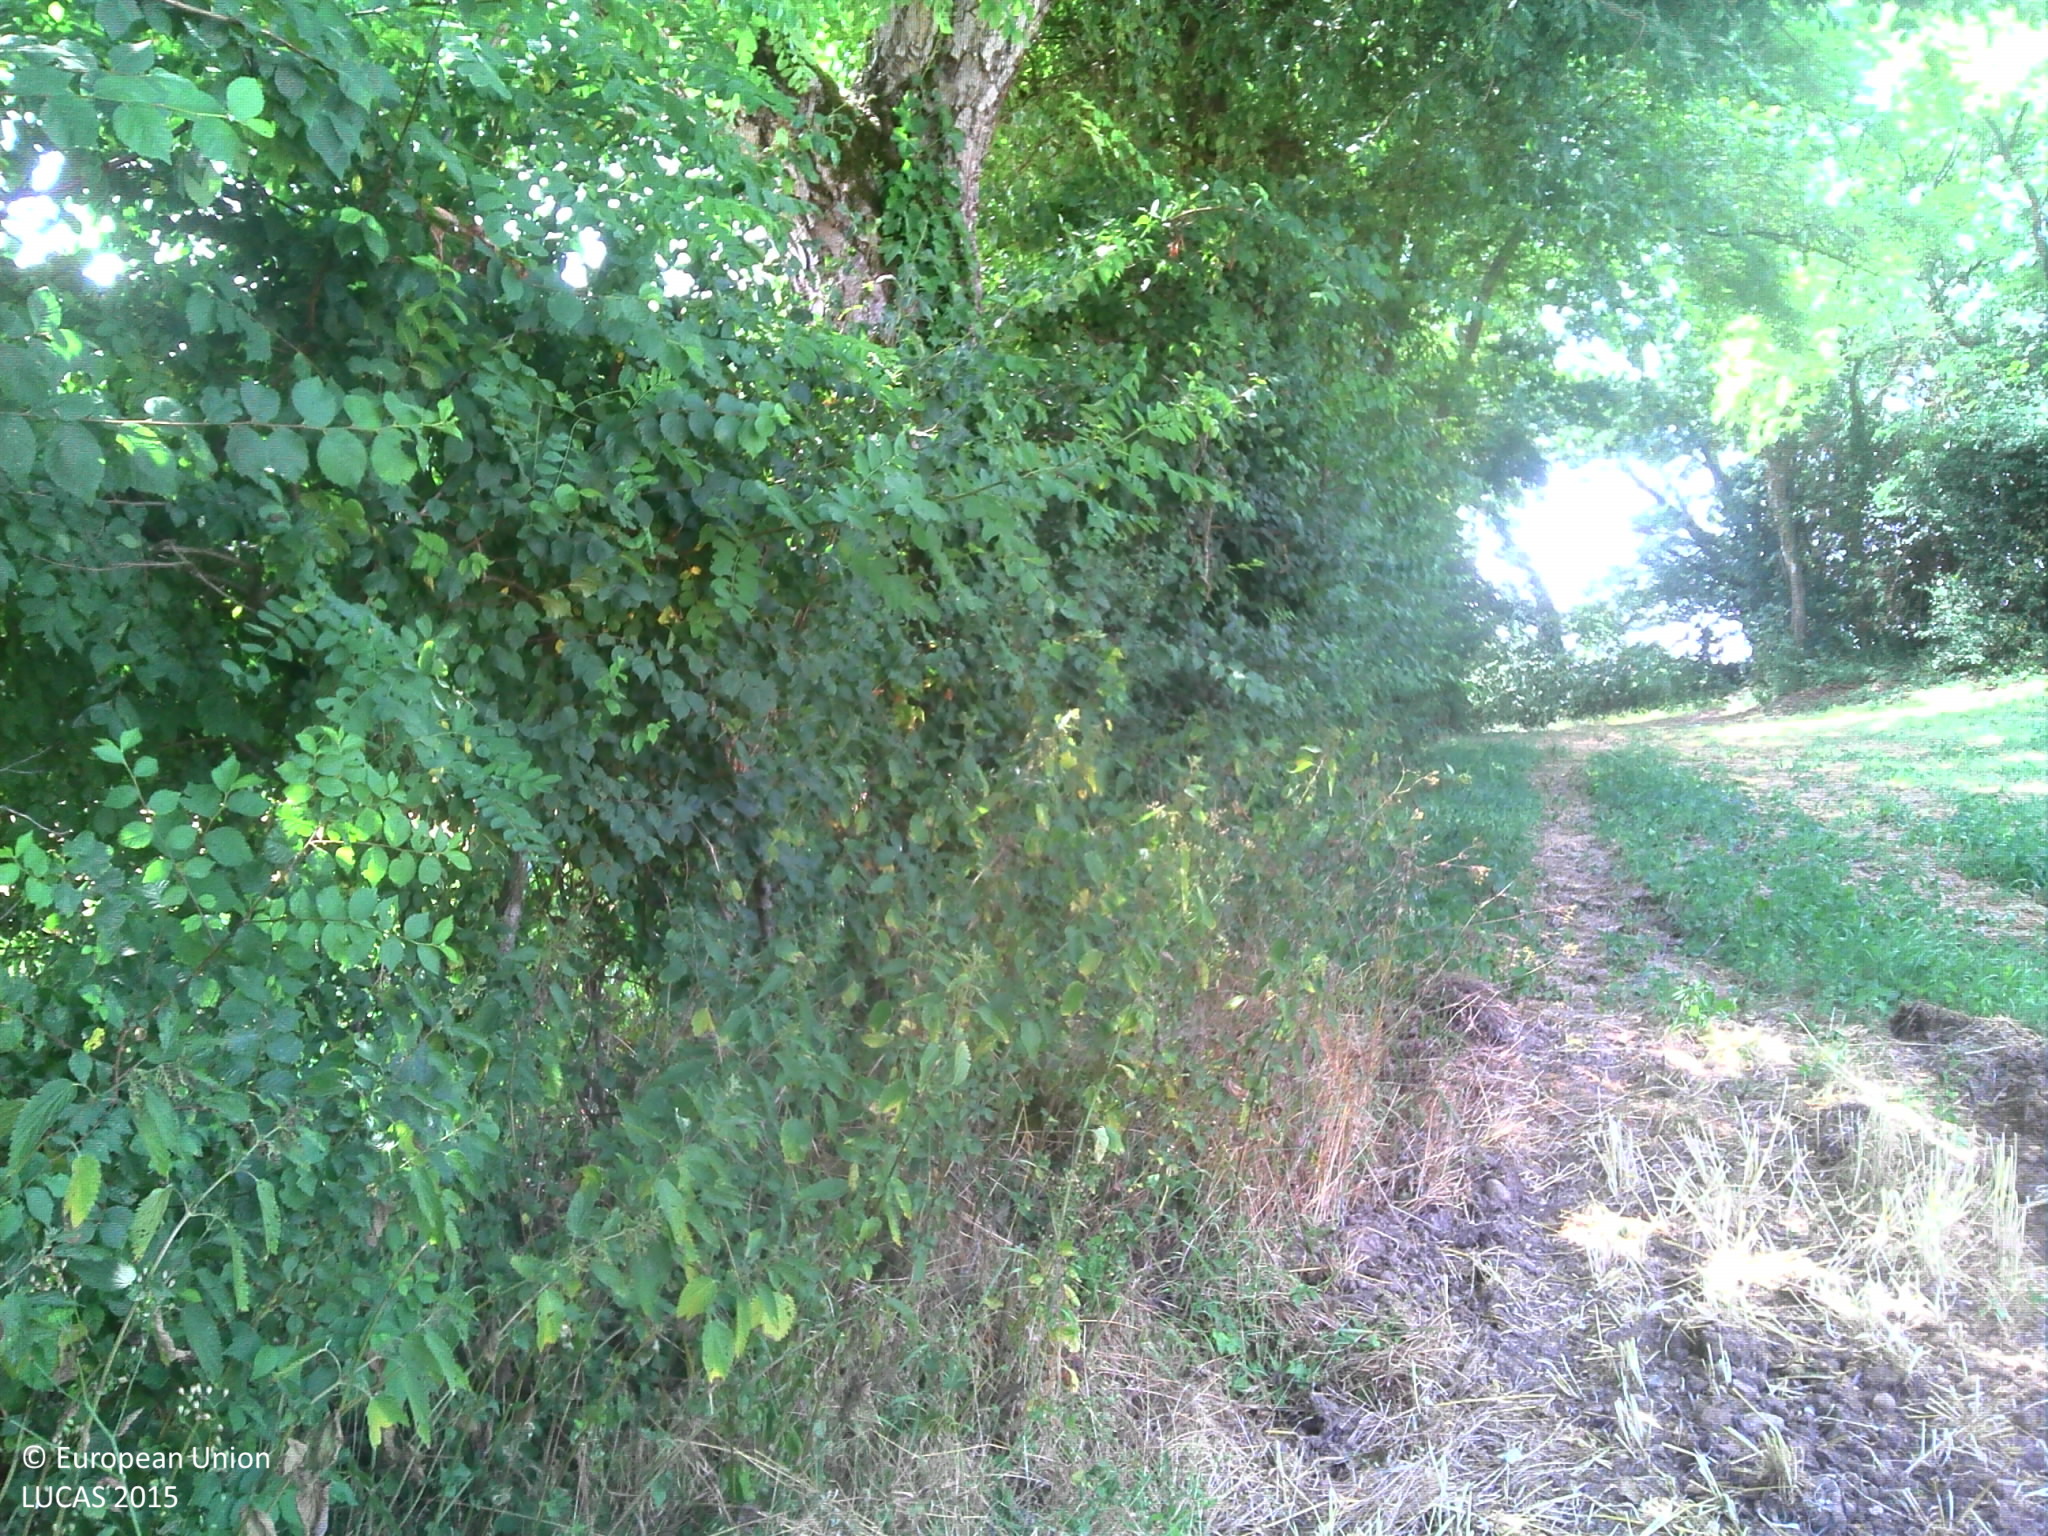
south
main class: Cropland
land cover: Common wheat
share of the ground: > 75 %
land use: Agriculture (excluding fallow land and kitchen gardens)
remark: Harvested field
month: July
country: FR
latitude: 45.7903
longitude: 5.1541
